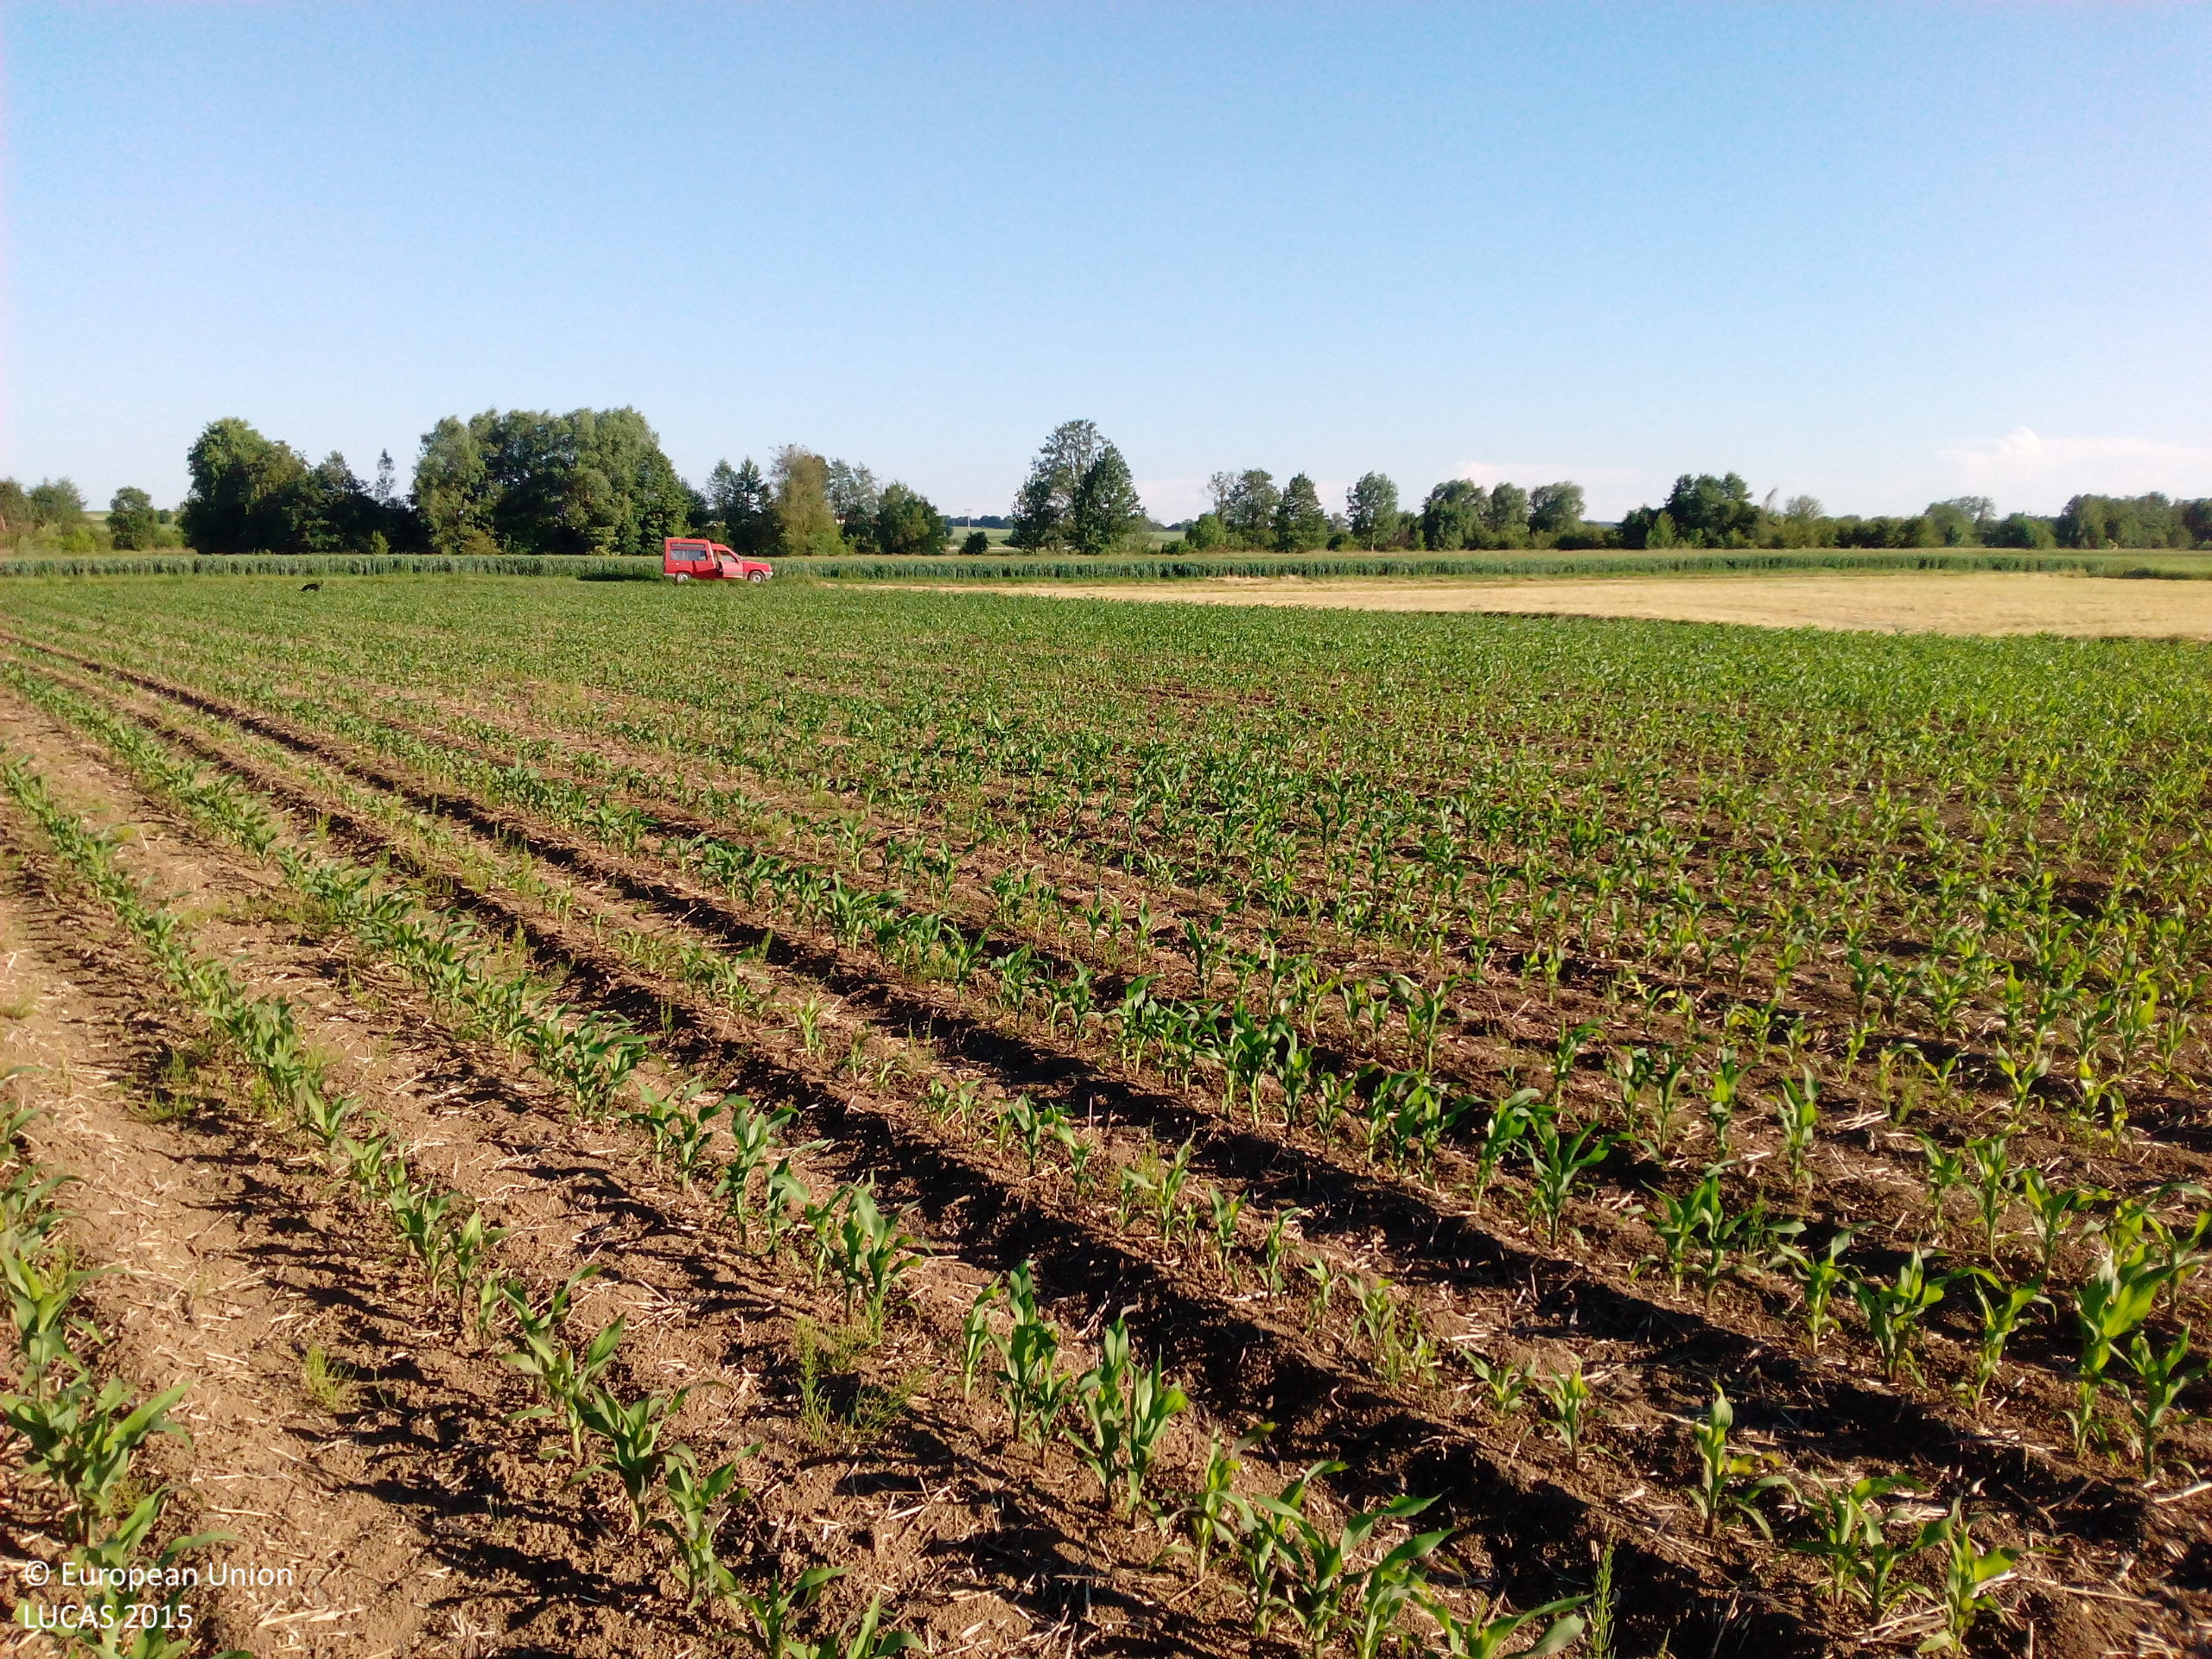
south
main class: Cropland
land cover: Maize
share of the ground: < 10 %
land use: Agriculture (excluding fallow land and kitchen gardens)
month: June
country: DE
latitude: 48.8452
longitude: 12.4112
